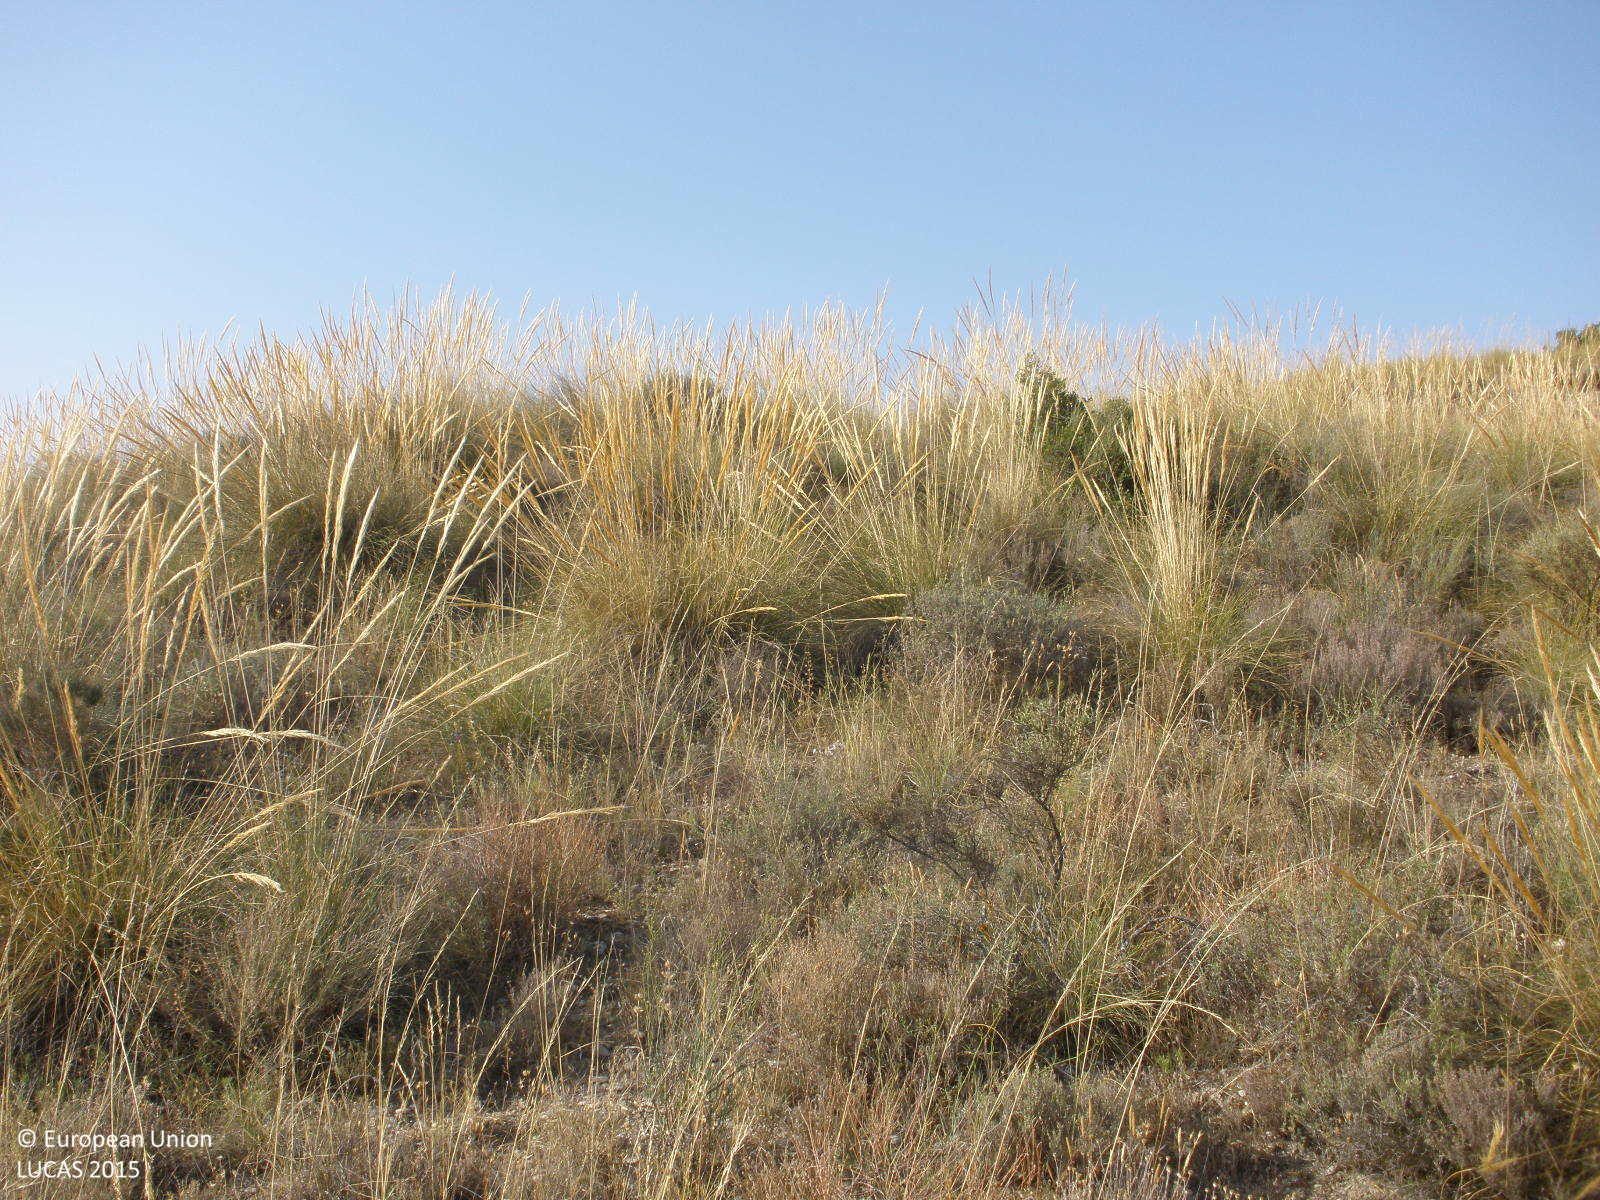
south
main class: Shrubland
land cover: Shrubland without tree cover
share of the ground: 25 - 50 %
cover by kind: herbaceous plants 60 %, shrubs 30 %, consolidated bare surface 10 %
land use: Semi-natural and natural areas not in use
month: July
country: ES
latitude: 40.0360
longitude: -3.4243
